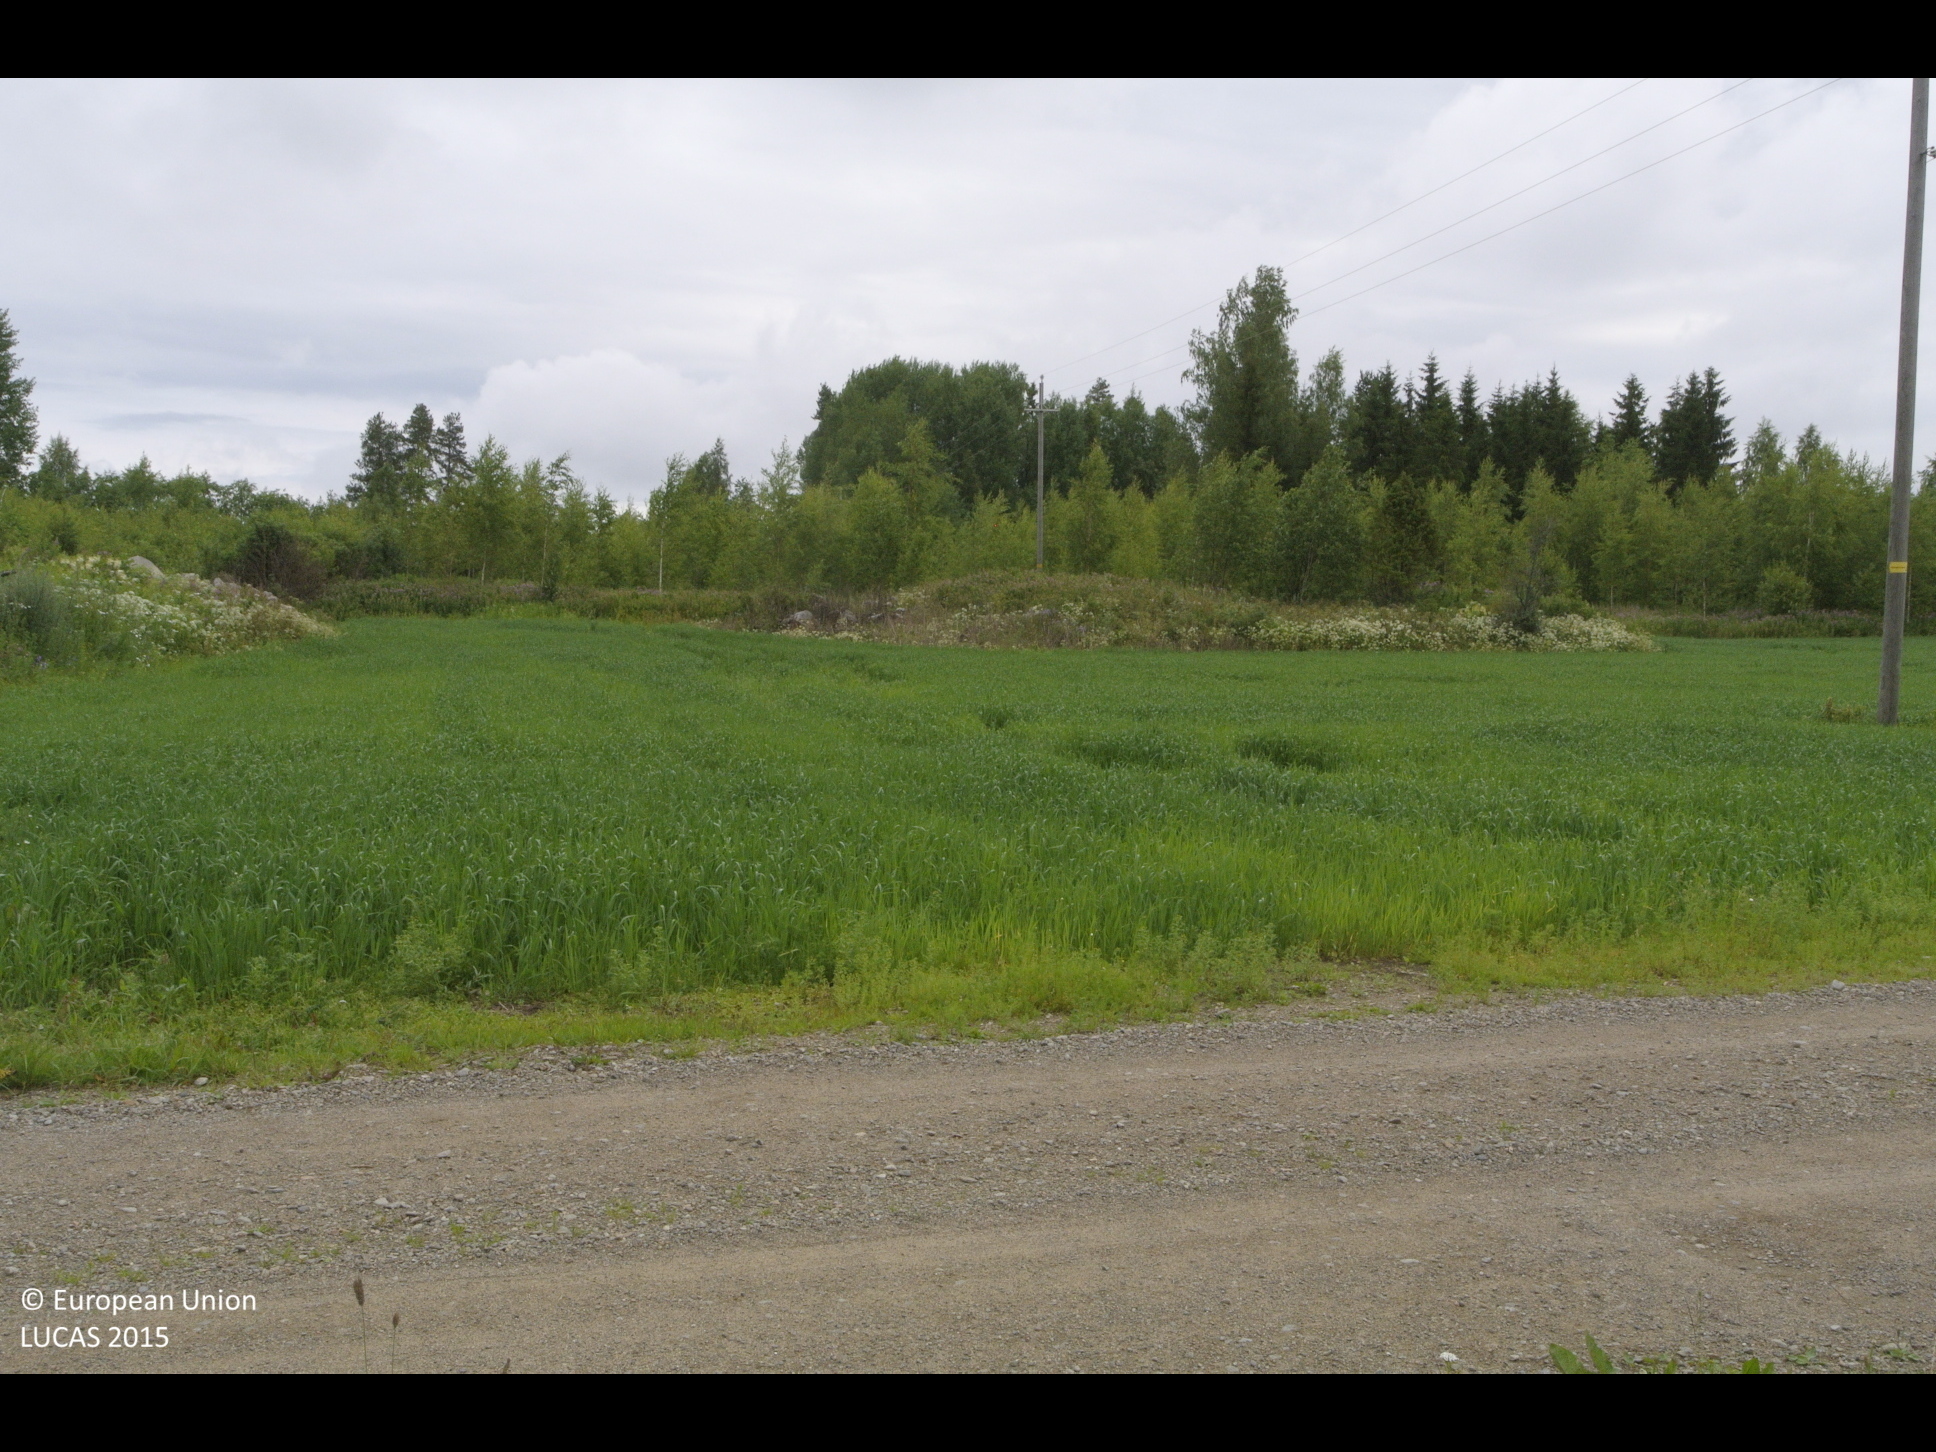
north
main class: Cropland
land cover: Oats
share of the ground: > 75 %
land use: Agriculture (excluding fallow land and kitchen gardens)
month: July
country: FI
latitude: 61.3870
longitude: 25.7588
